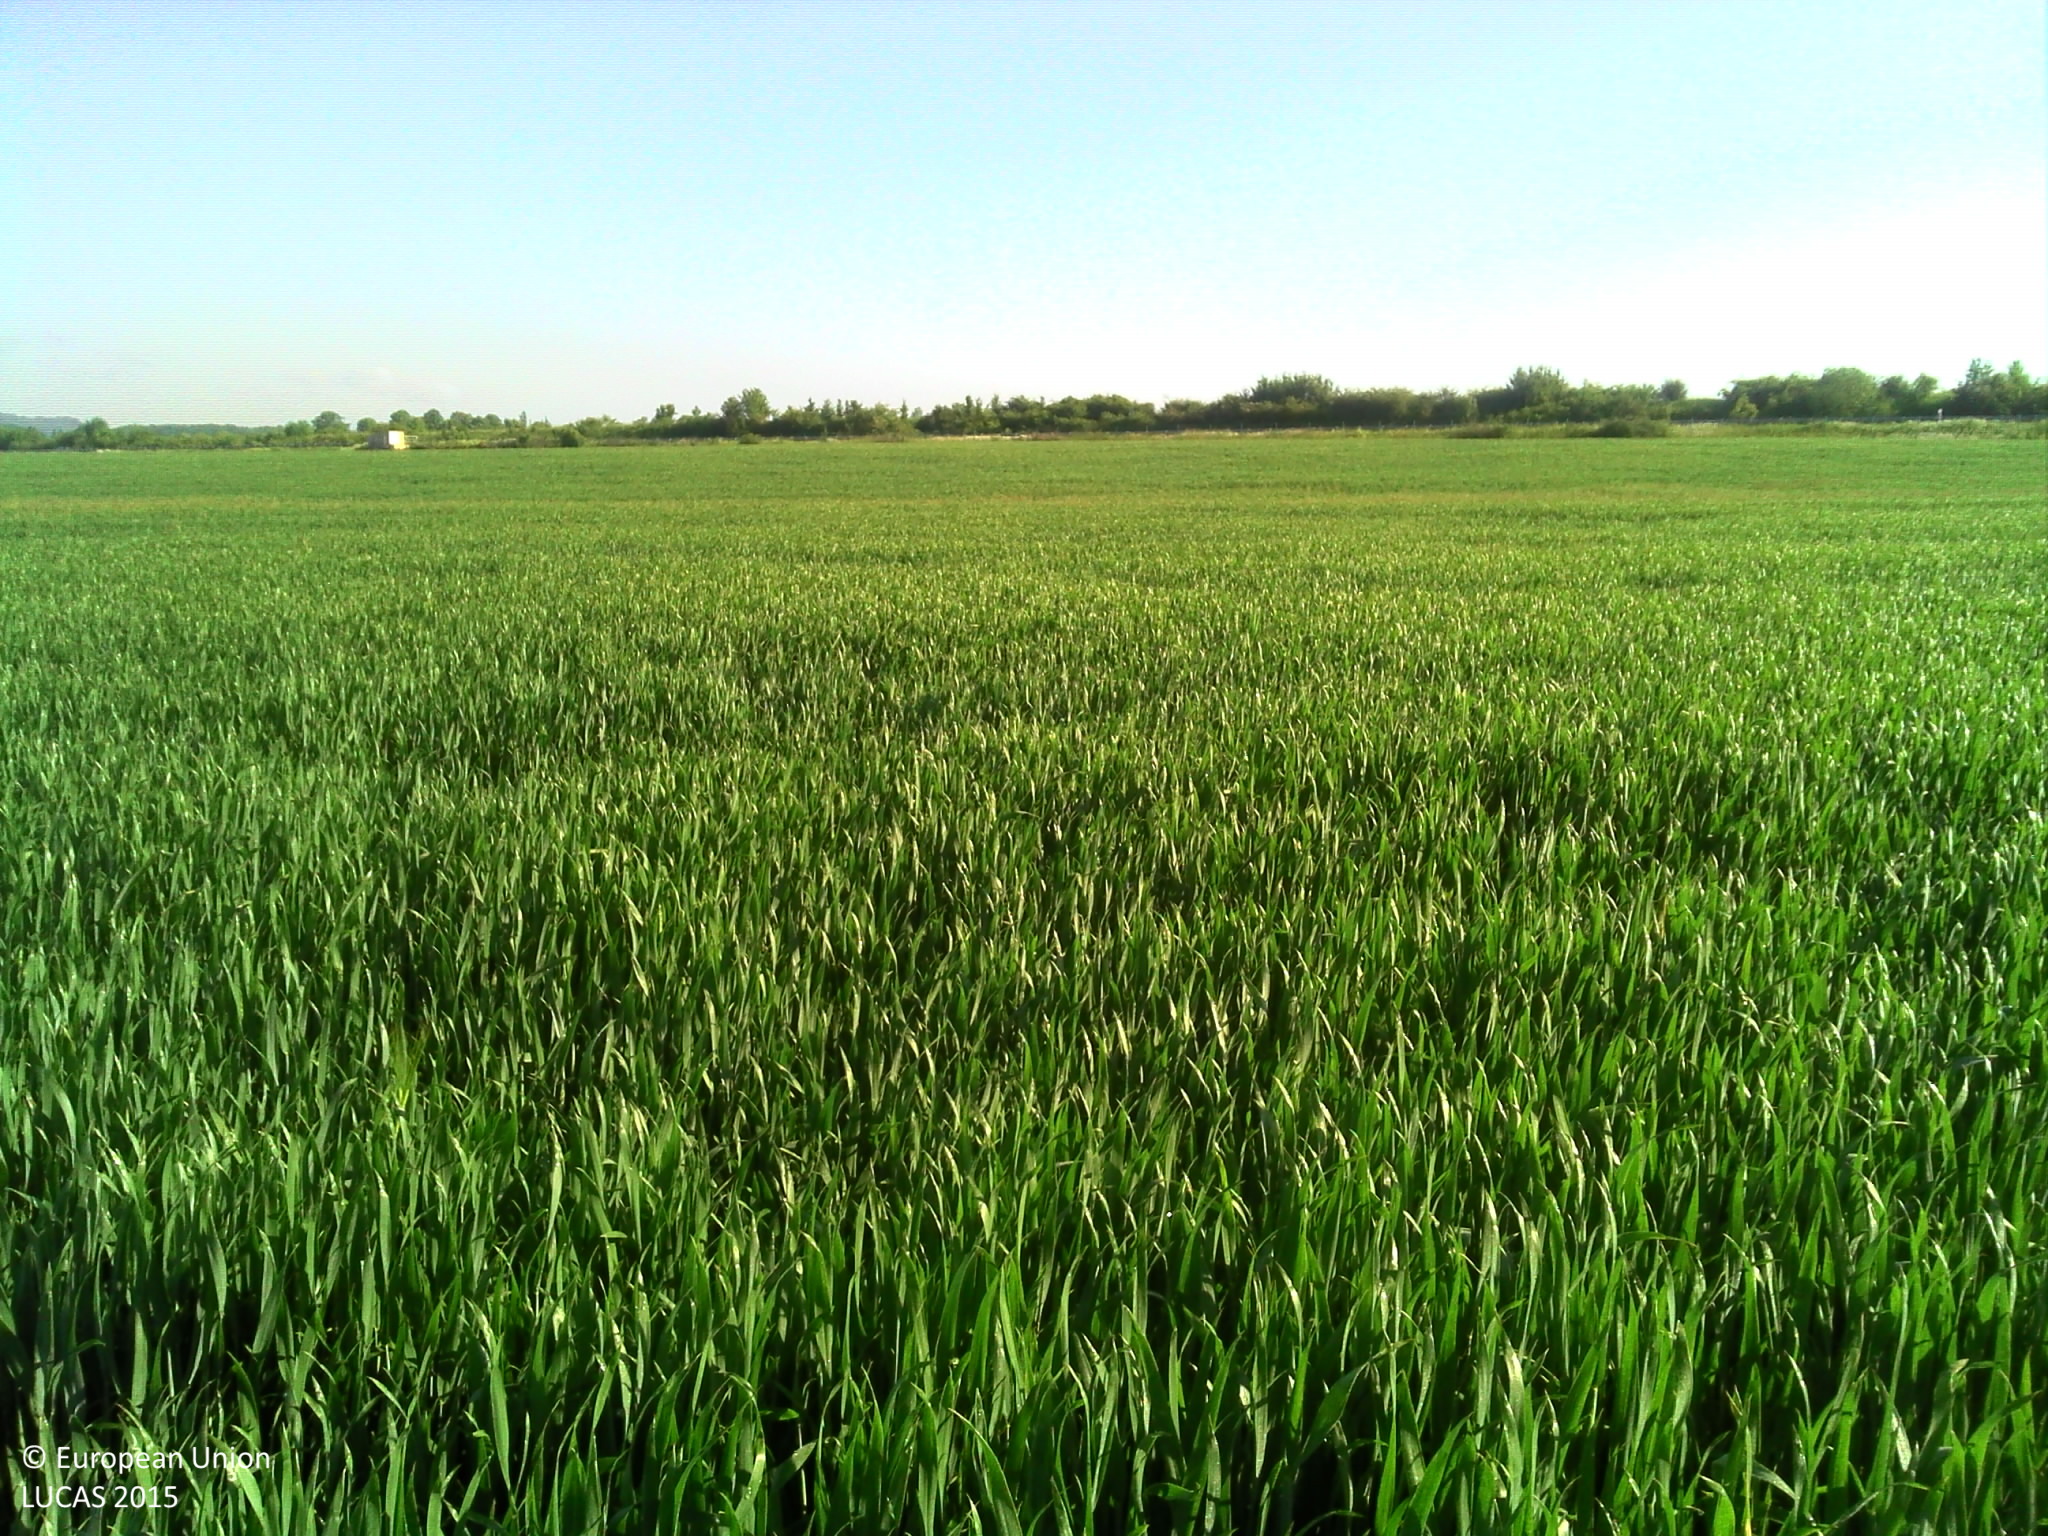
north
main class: Cropland
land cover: Common wheat
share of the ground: > 75 %
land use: Agriculture (excluding fallow land and kitchen gardens)
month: May
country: LU
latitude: 49.4946
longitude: 6.3134
